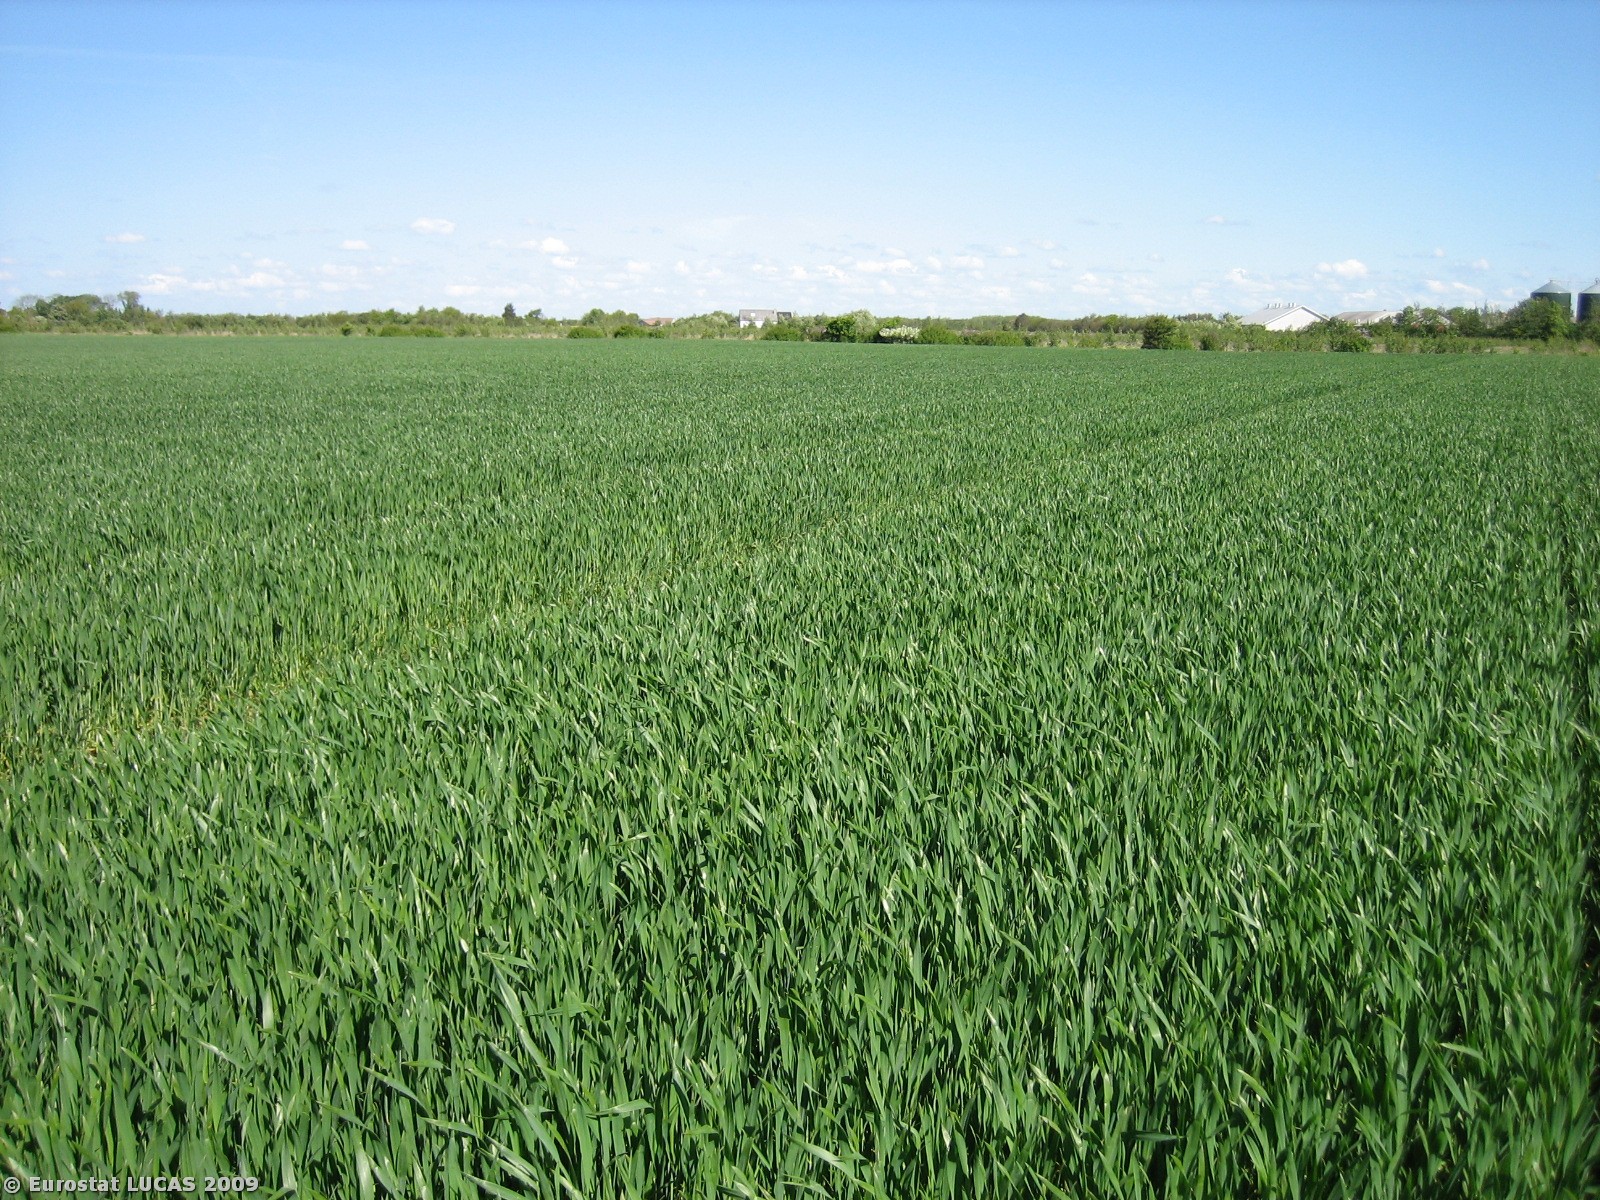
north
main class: Cropland
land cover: Common wheat
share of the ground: > 75 %
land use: Agriculture (excluding fallow land and kitchen gardens)
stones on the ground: < 10 %
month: May
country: DK
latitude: 55.9443
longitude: 8.4165
